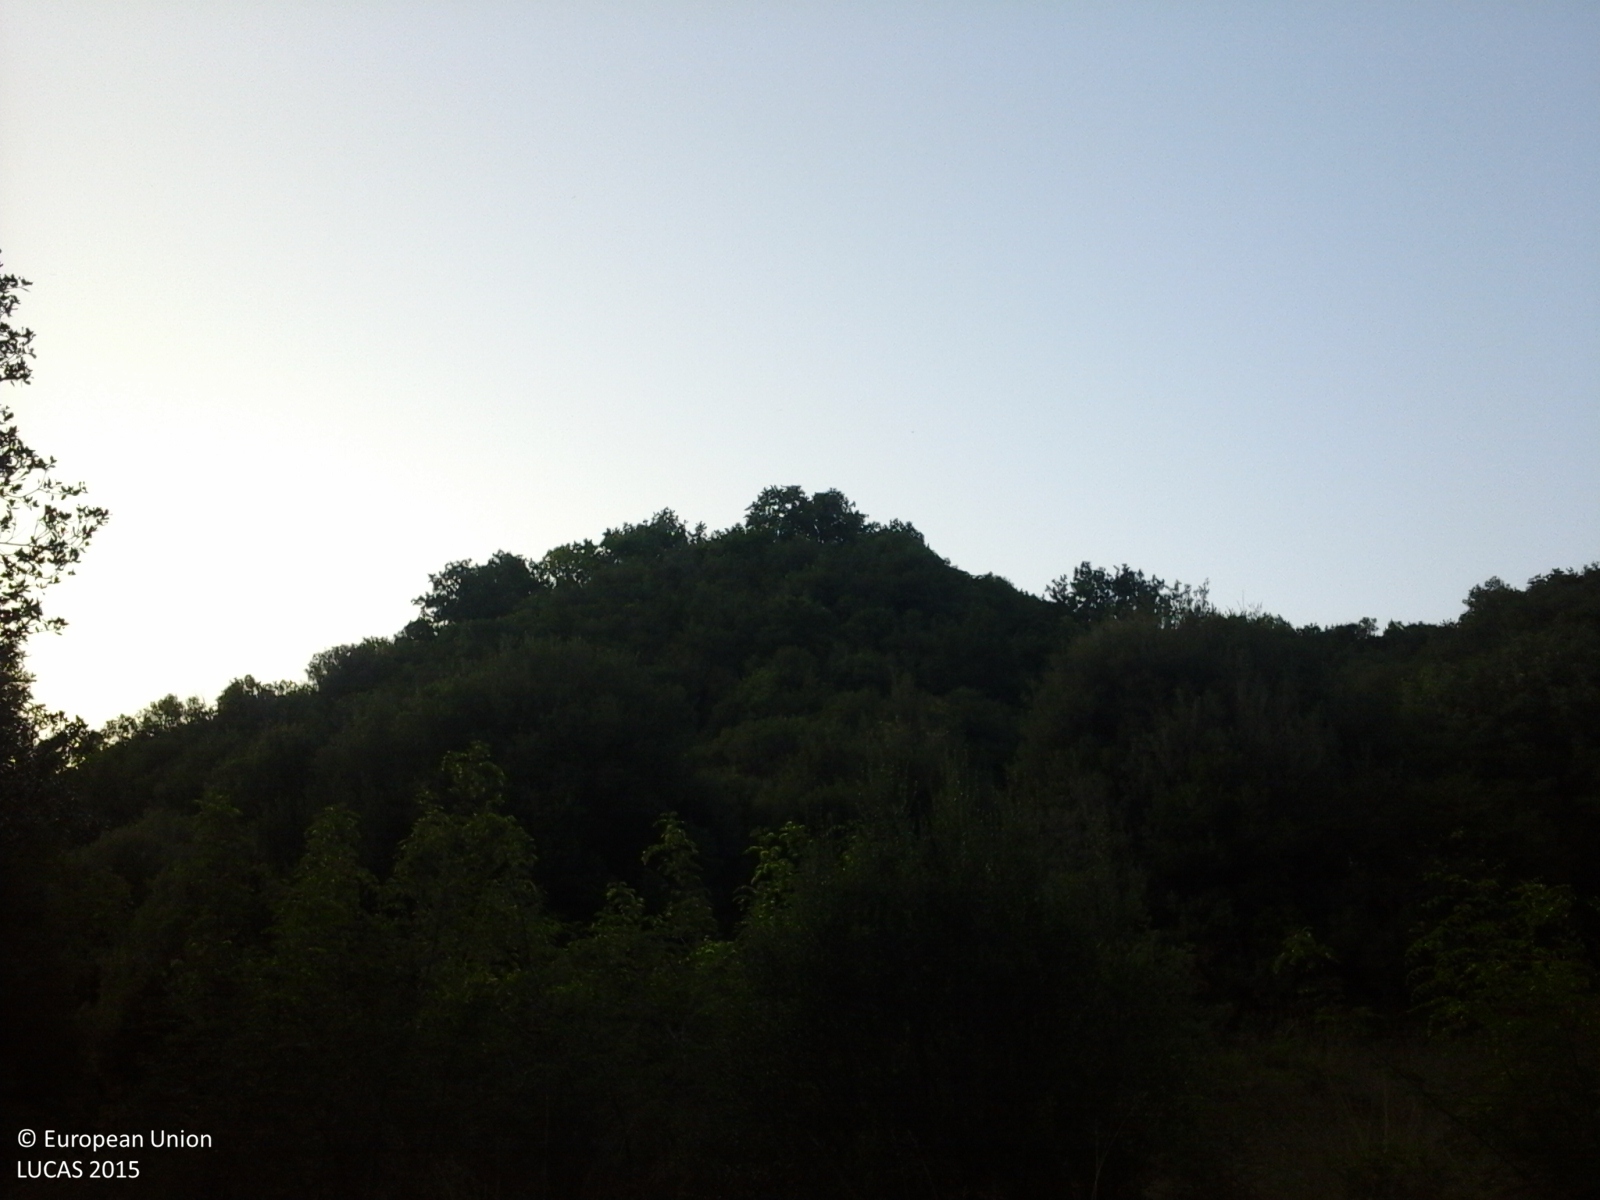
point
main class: Woodland
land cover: Broadleaved woodland
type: thermophilous deciduous forest
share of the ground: > 75 %
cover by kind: broadleaved forest trees 80 %, herbaceous plants 15 %, shrubs 5 %
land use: Forestry
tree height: > 5 m
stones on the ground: < 10 %
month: July
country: GR
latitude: 39.4024
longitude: 20.7401
